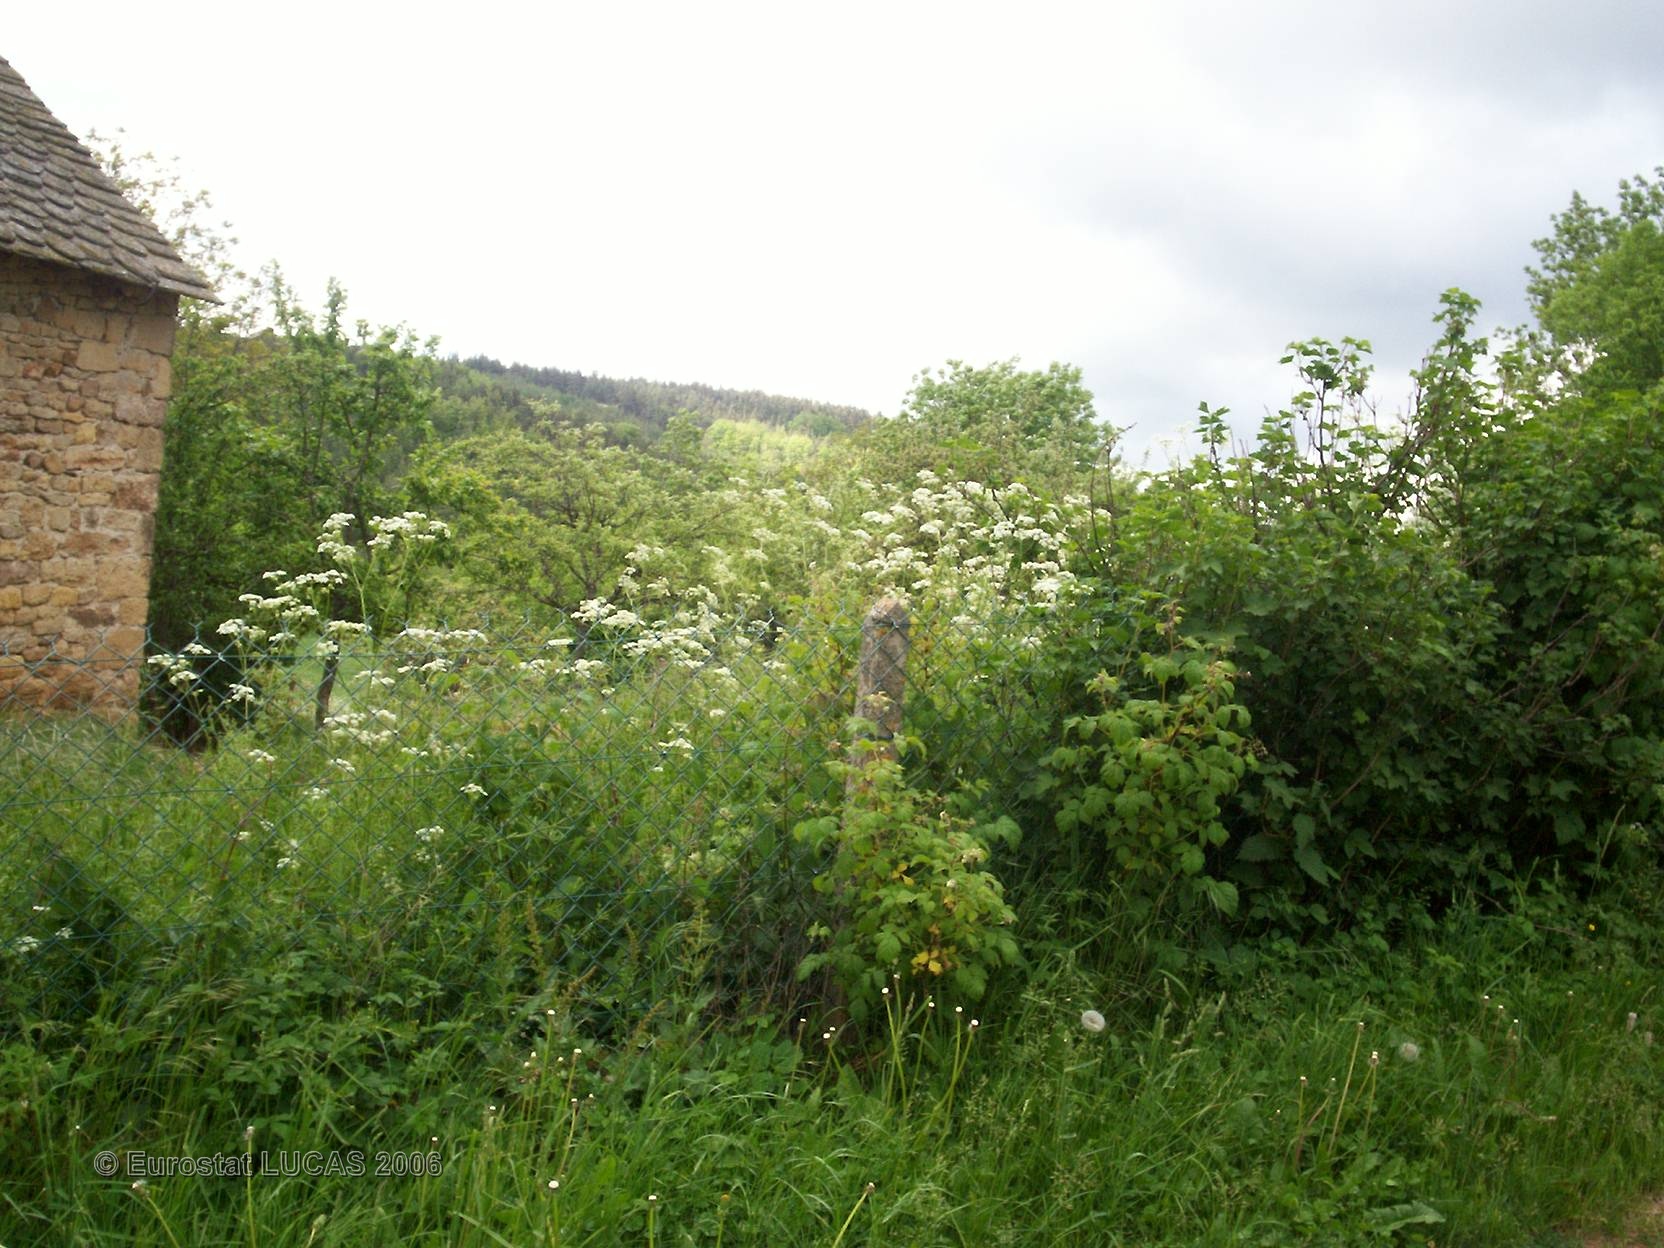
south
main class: Grassland
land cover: Grassland with sparse tree/shrub cover
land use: Residential
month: May
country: FR
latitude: 44.5904
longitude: 3.3663
